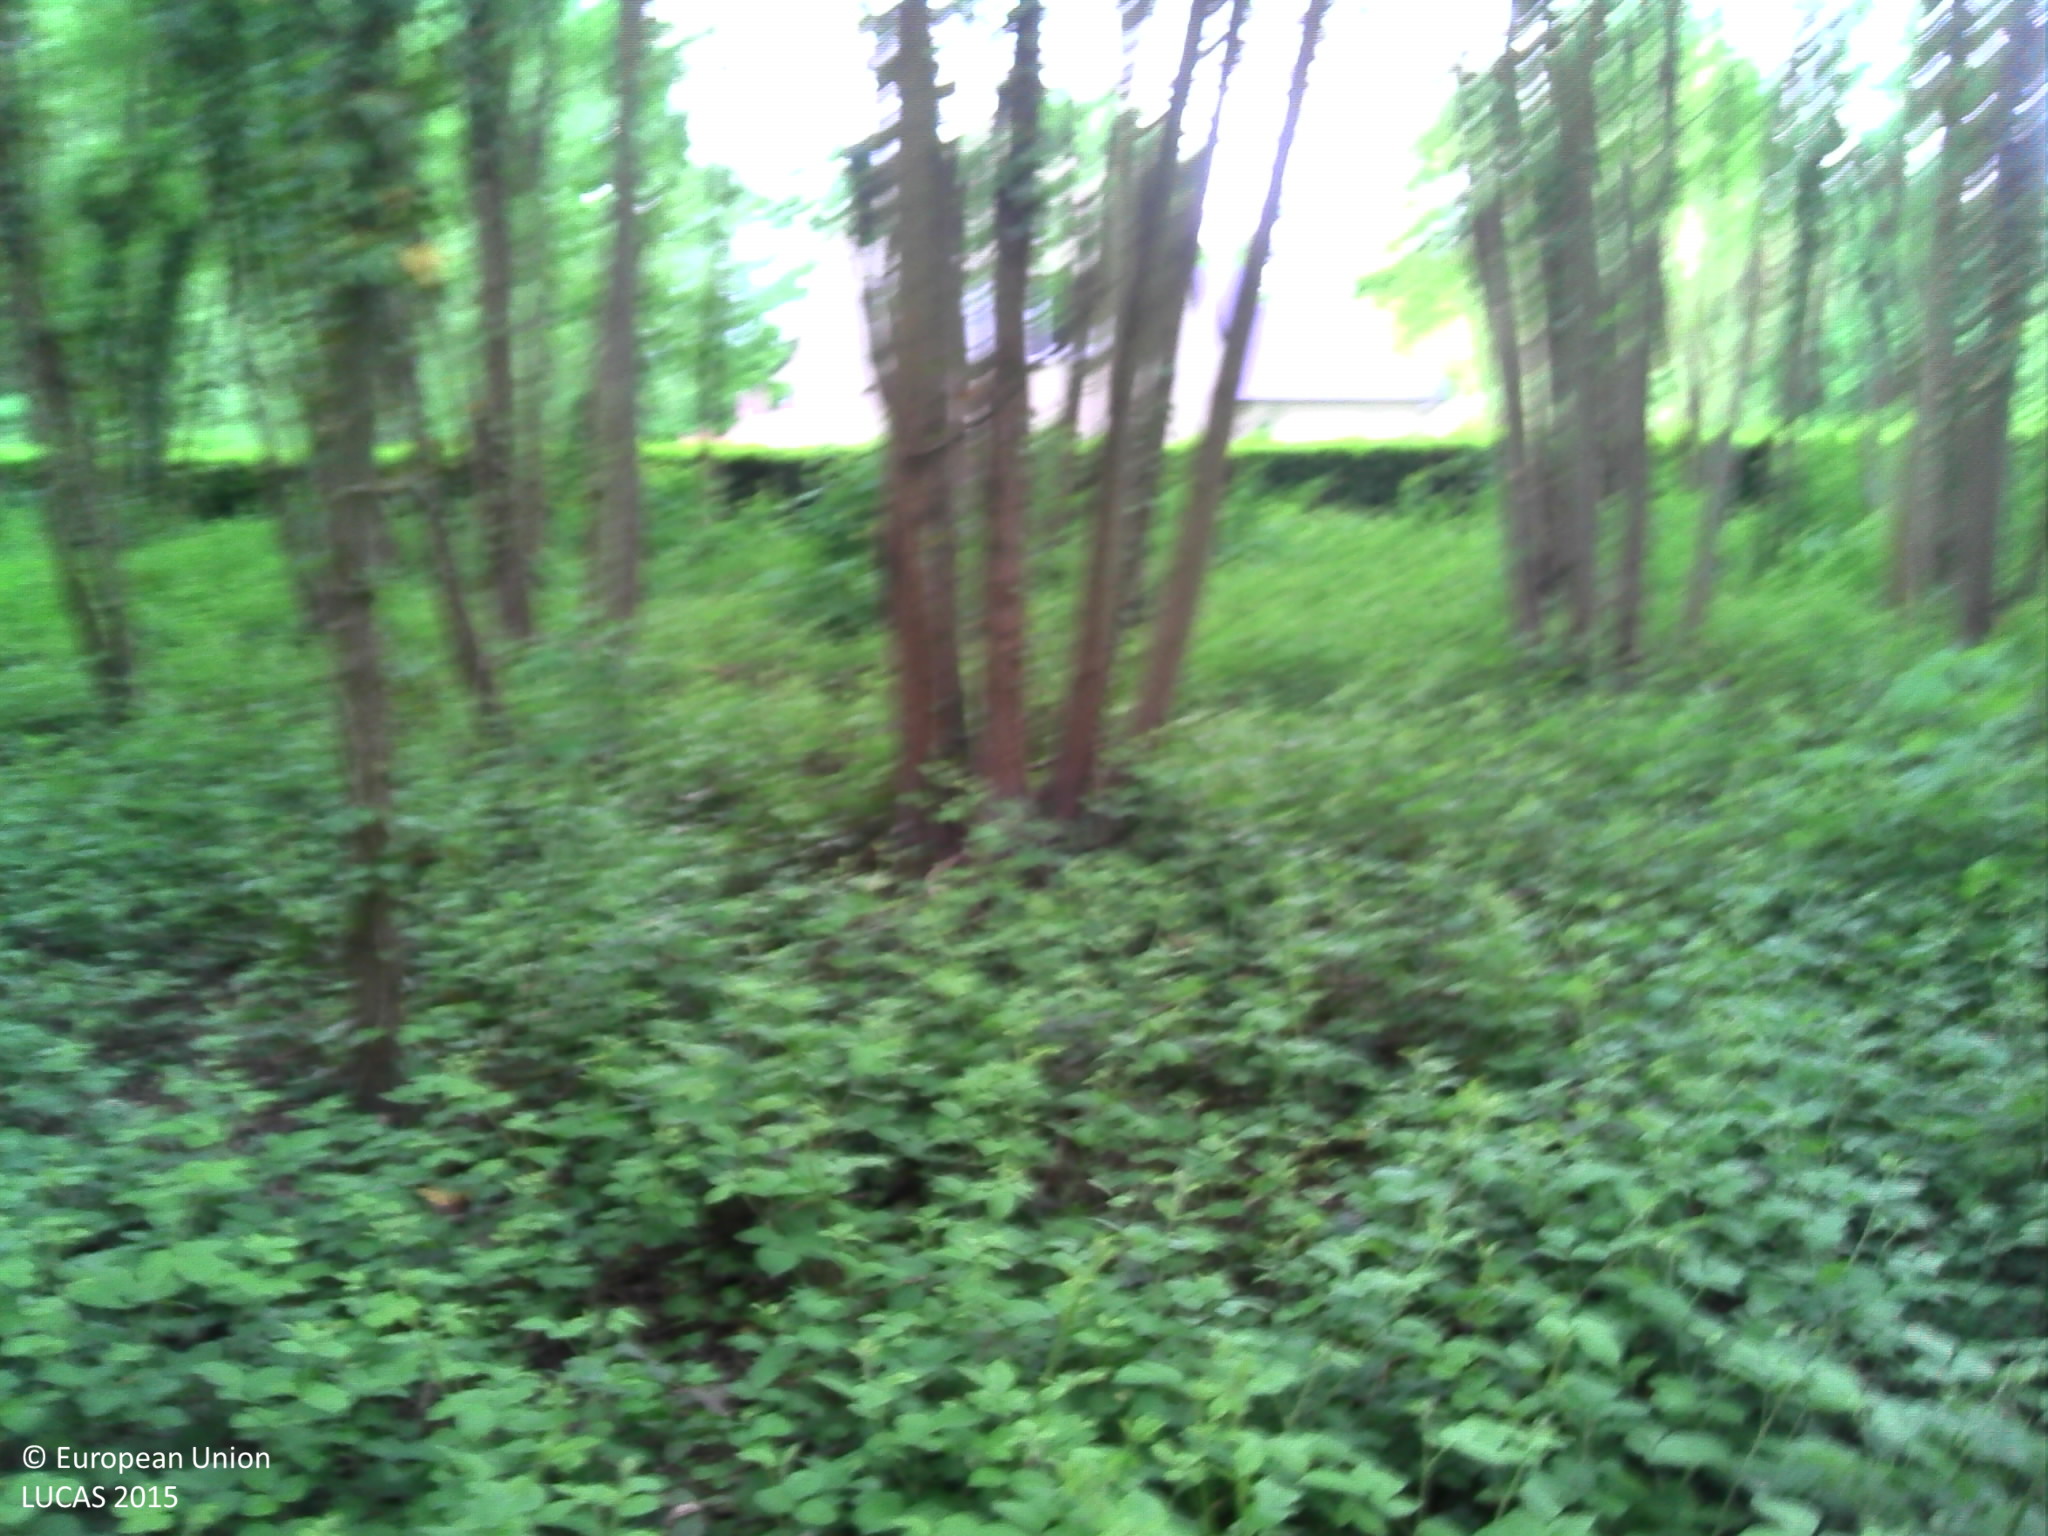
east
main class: Woodland
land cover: Broadleaved woodland
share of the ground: > 75 %
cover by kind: broadleaved forest trees 100 %
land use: Forestry
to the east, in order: Broadleaved woodland; Artificial constructions in urban areas; Broadleaved woodland; Artificial constructions in urban areas; Spruce dominated coniferous woodland
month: May
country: BE
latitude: 50.6984
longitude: 4.4599
